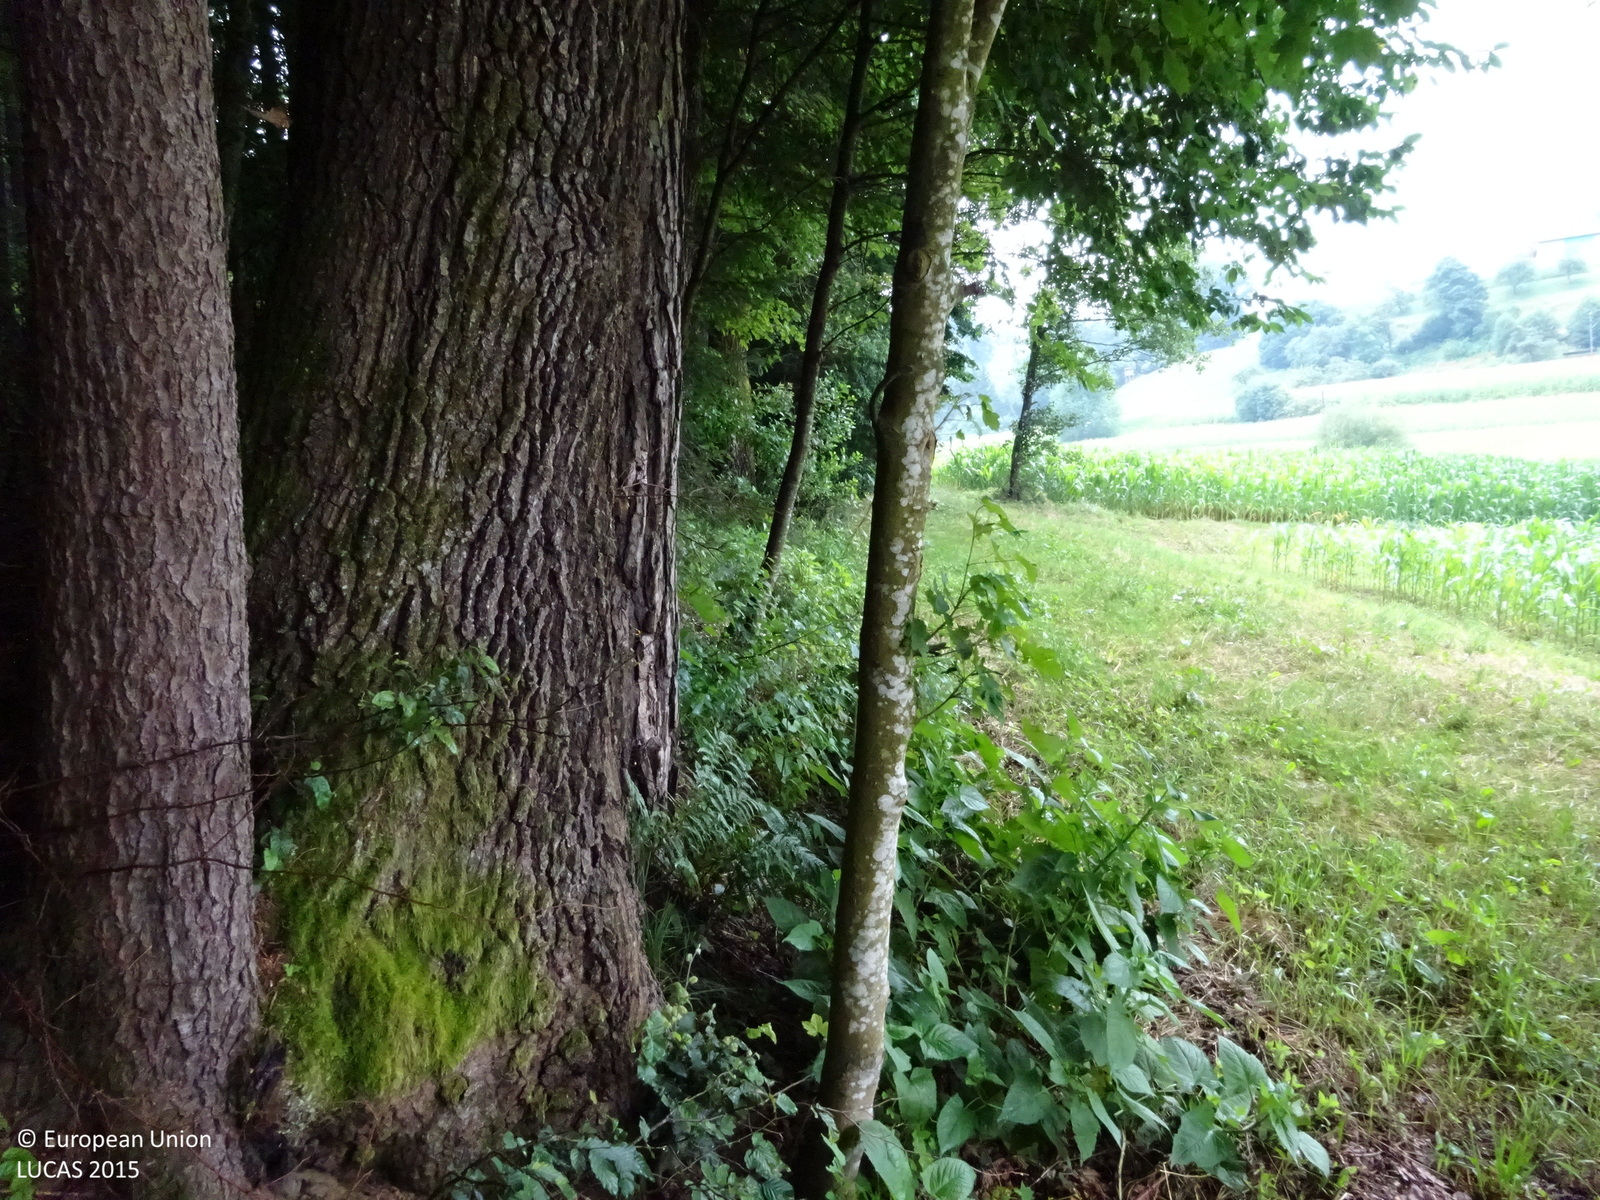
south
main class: Woodland
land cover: Spruce dominated mixed woodland
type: mountainous beech forest
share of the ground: > 75 %
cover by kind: coniferous forest trees 50 %, broadleaved forest trees 50 %
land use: Forestry
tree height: > 5 m
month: July
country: AT
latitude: 46.7971
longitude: 15.3052
